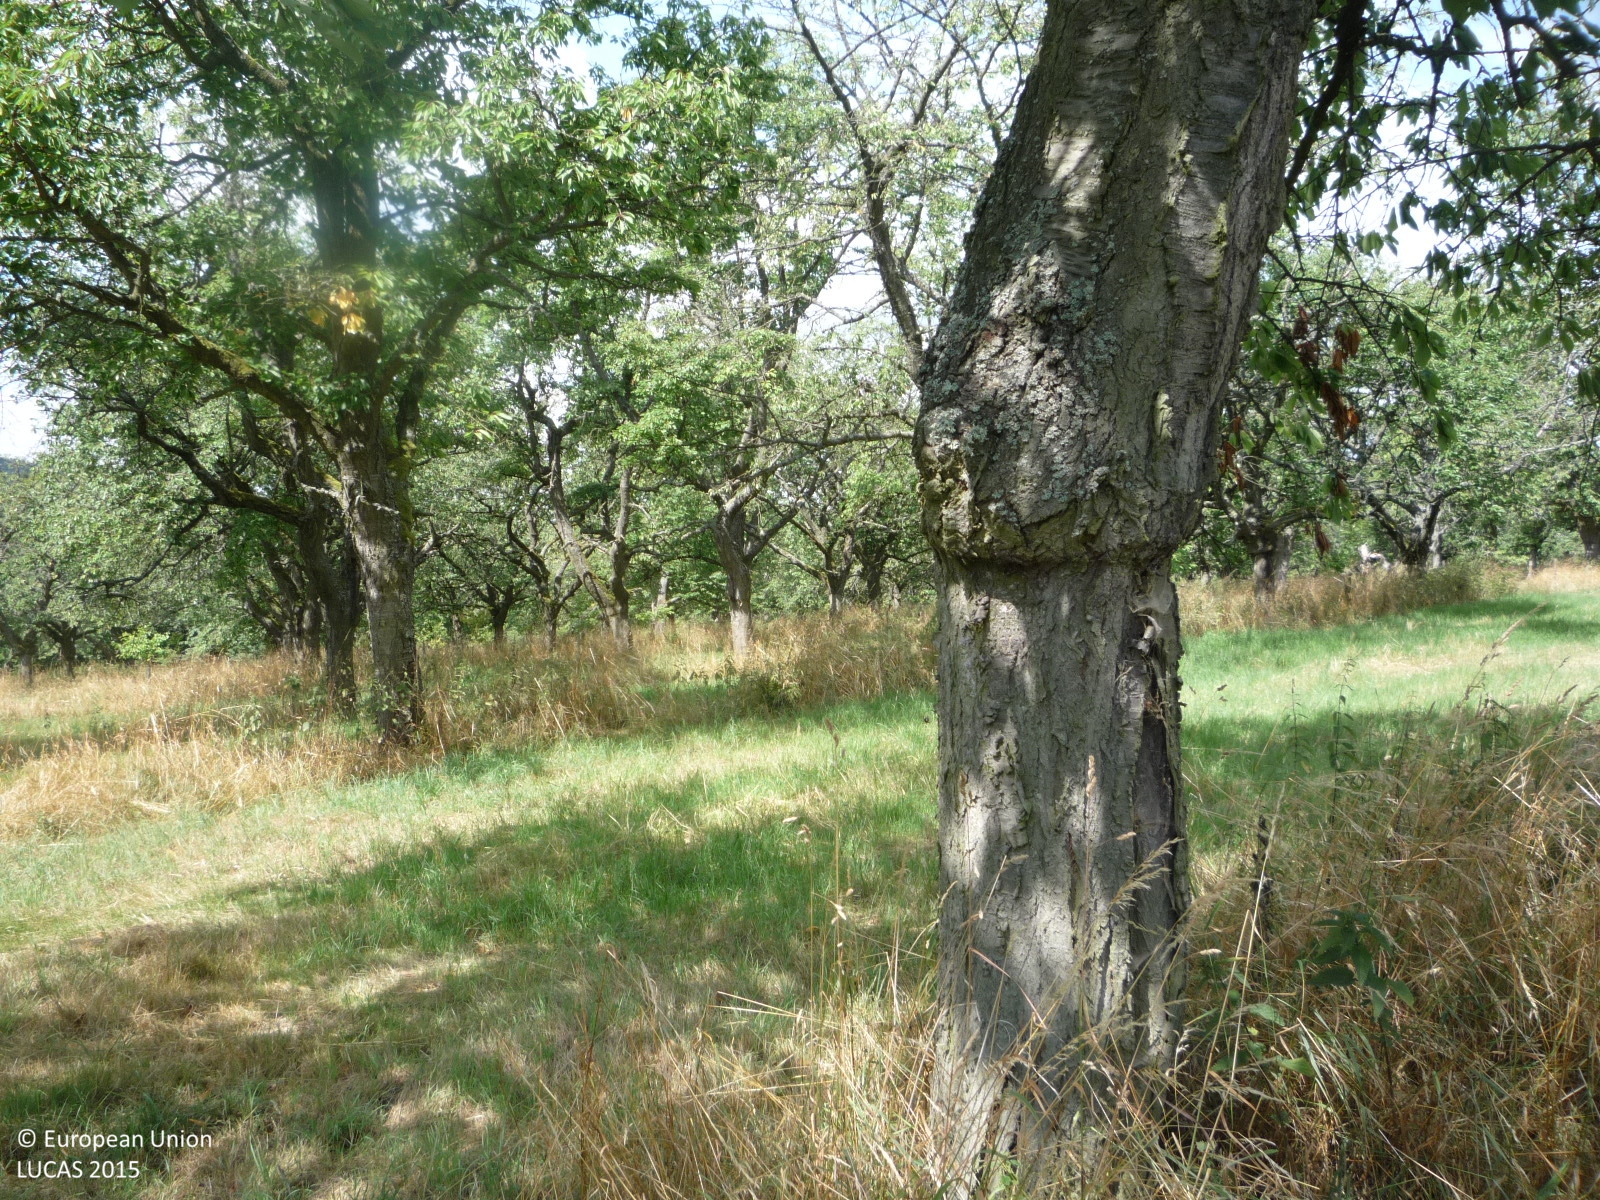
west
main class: Cropland
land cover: Cherry fruit
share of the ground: 50 - 75 %
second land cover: Grassland without tree/shrub cover
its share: 25 - 50 %
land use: Agriculture (excluding fallow land and kitchen gardens)
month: July
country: CZ
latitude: 50.4978
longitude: 15.2054
